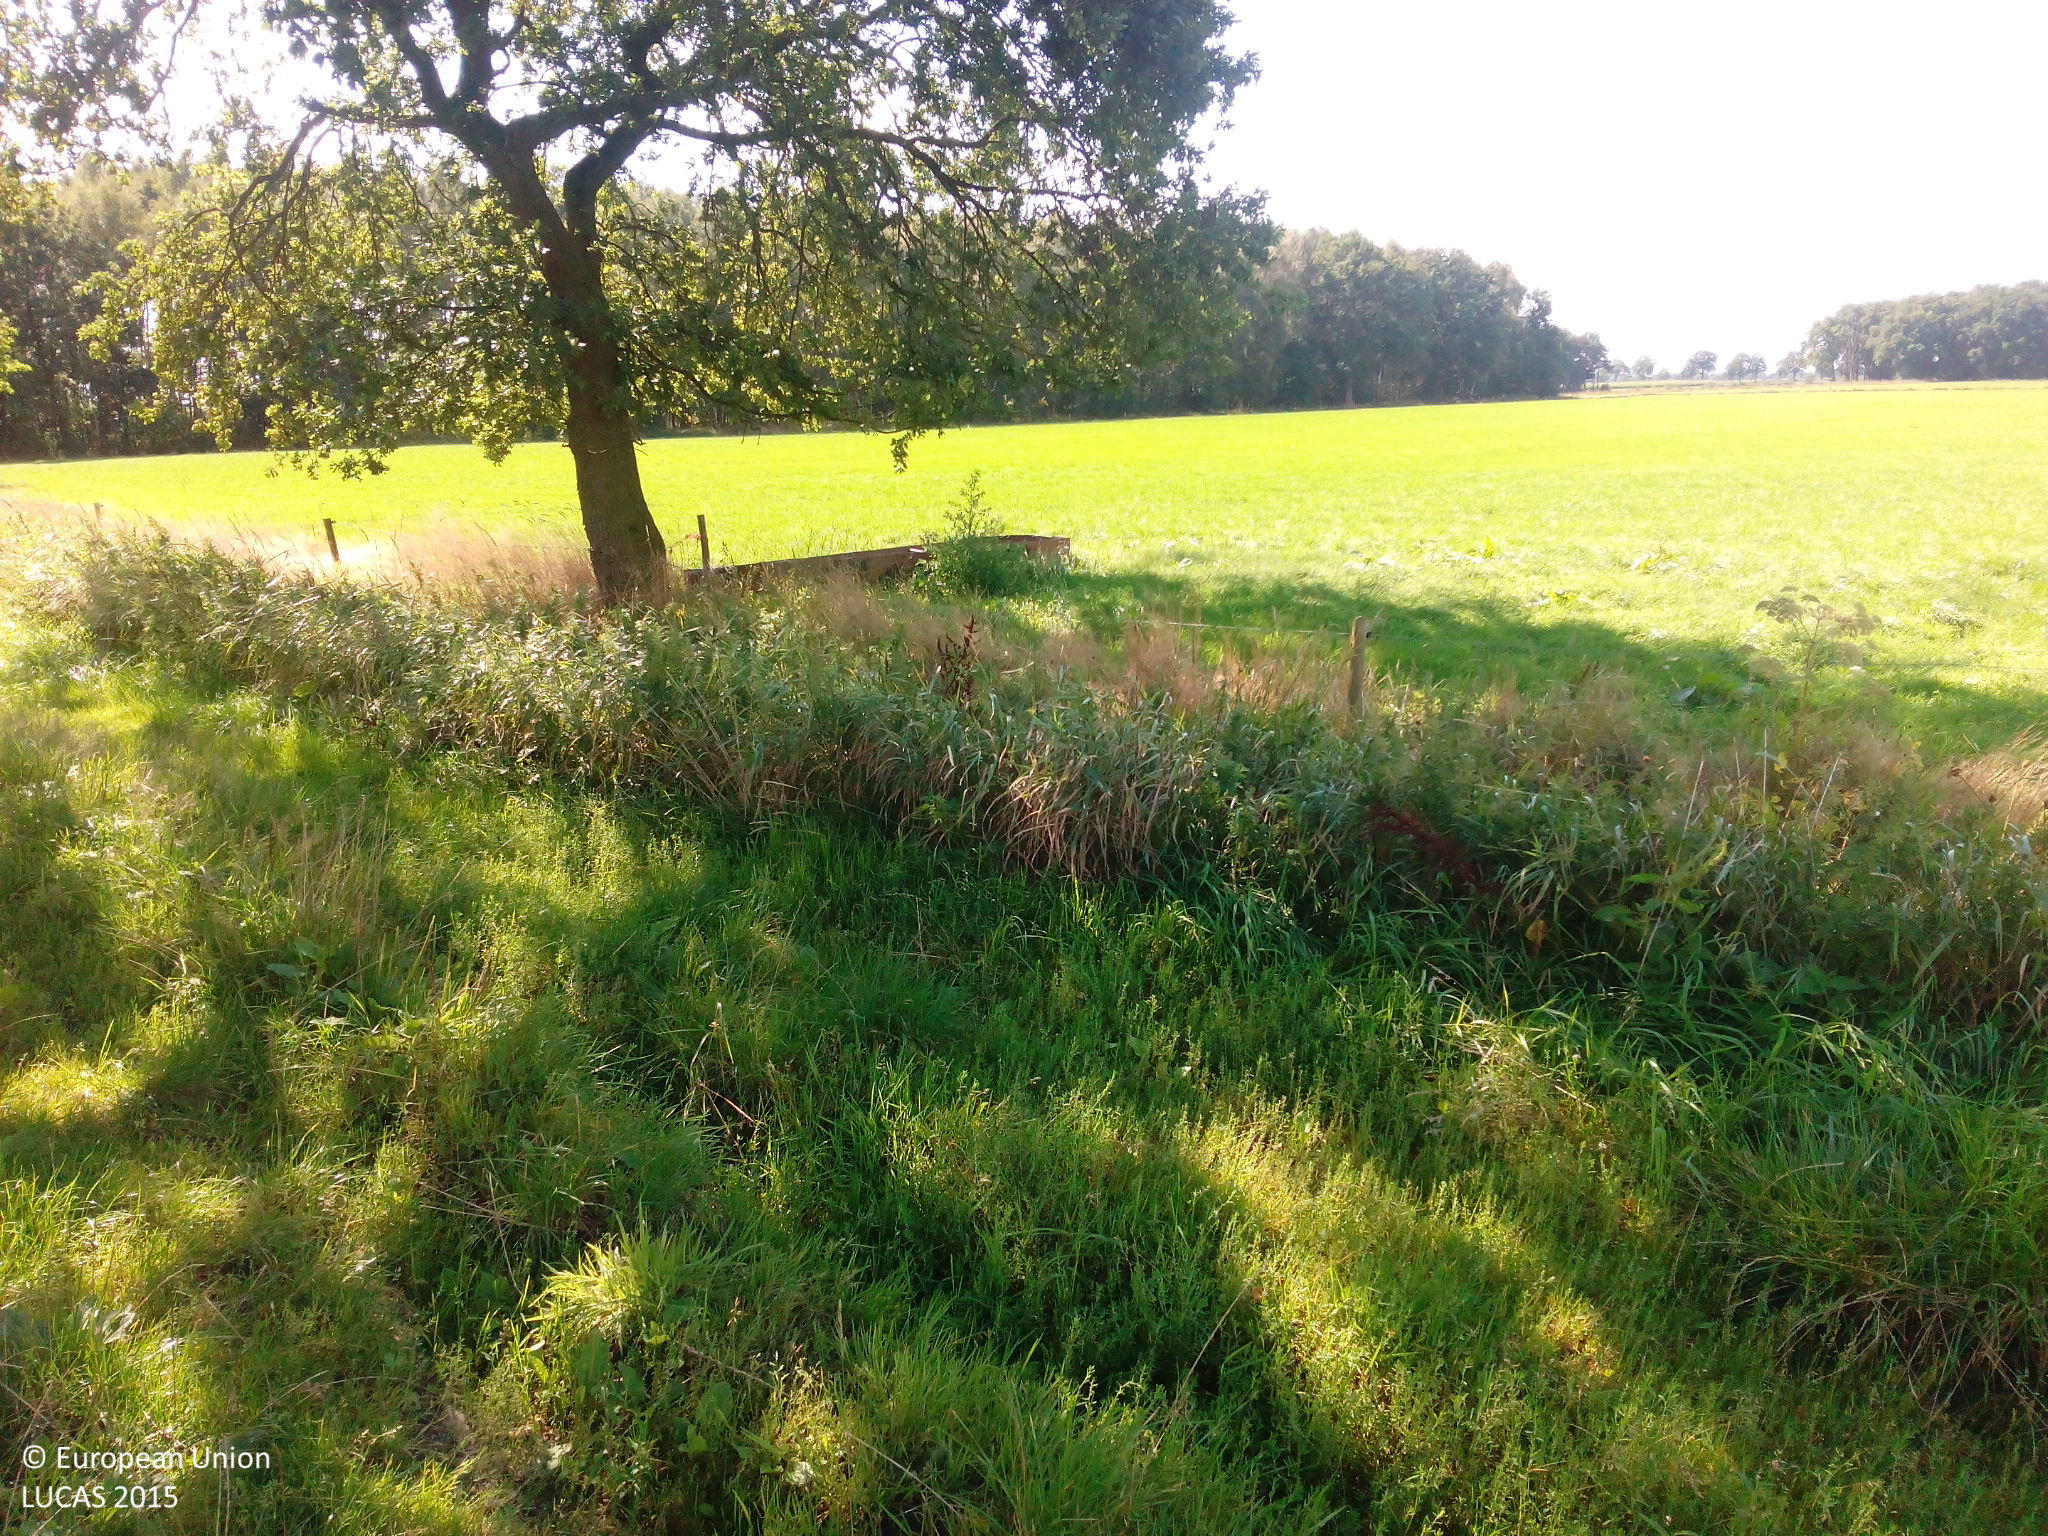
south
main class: Cropland
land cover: Maize
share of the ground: > 75 %
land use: Agriculture (excluding fallow land and kitchen gardens)
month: August
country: NL
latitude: 51.3099
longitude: 5.7091
